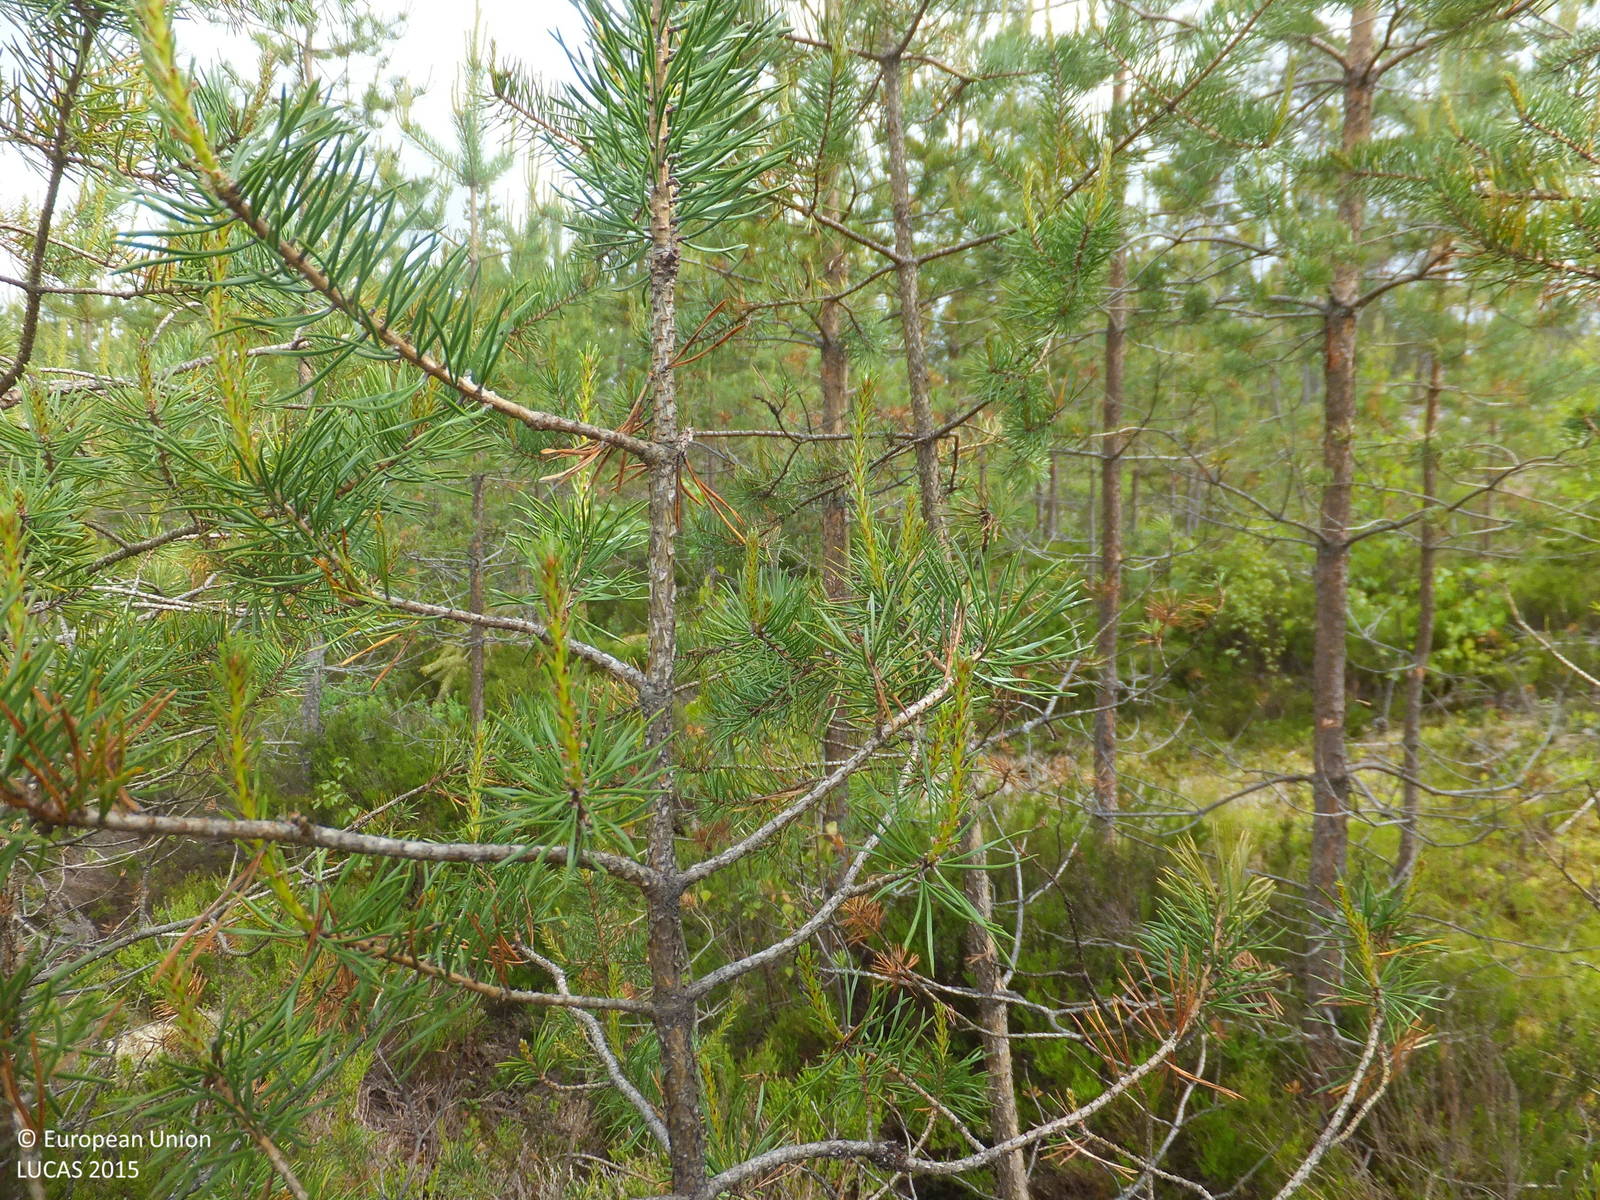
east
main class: Woodland
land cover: Pine dominated coniferous woodland
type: mire and swamp forests
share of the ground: > 75 %
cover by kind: coniferous forest trees 80 %, shrubs 10 %, broadleaved forest trees 5 %, lichens and mosses 5 %
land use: Forestry
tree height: < 5 m
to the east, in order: Pine dominated coniferous woodland; Lichens and moss; Pine dominated coniferous woodland; Lichens and moss; Pine dominated coniferous woodland; Lichens and moss; Pine dominated coniferous woodland; Lichens and moss; Pine dominated coniferous woodland; Rocks and stones; Pine dominated coniferous woodland
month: June
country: FI
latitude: 63.2836
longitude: 23.9277
